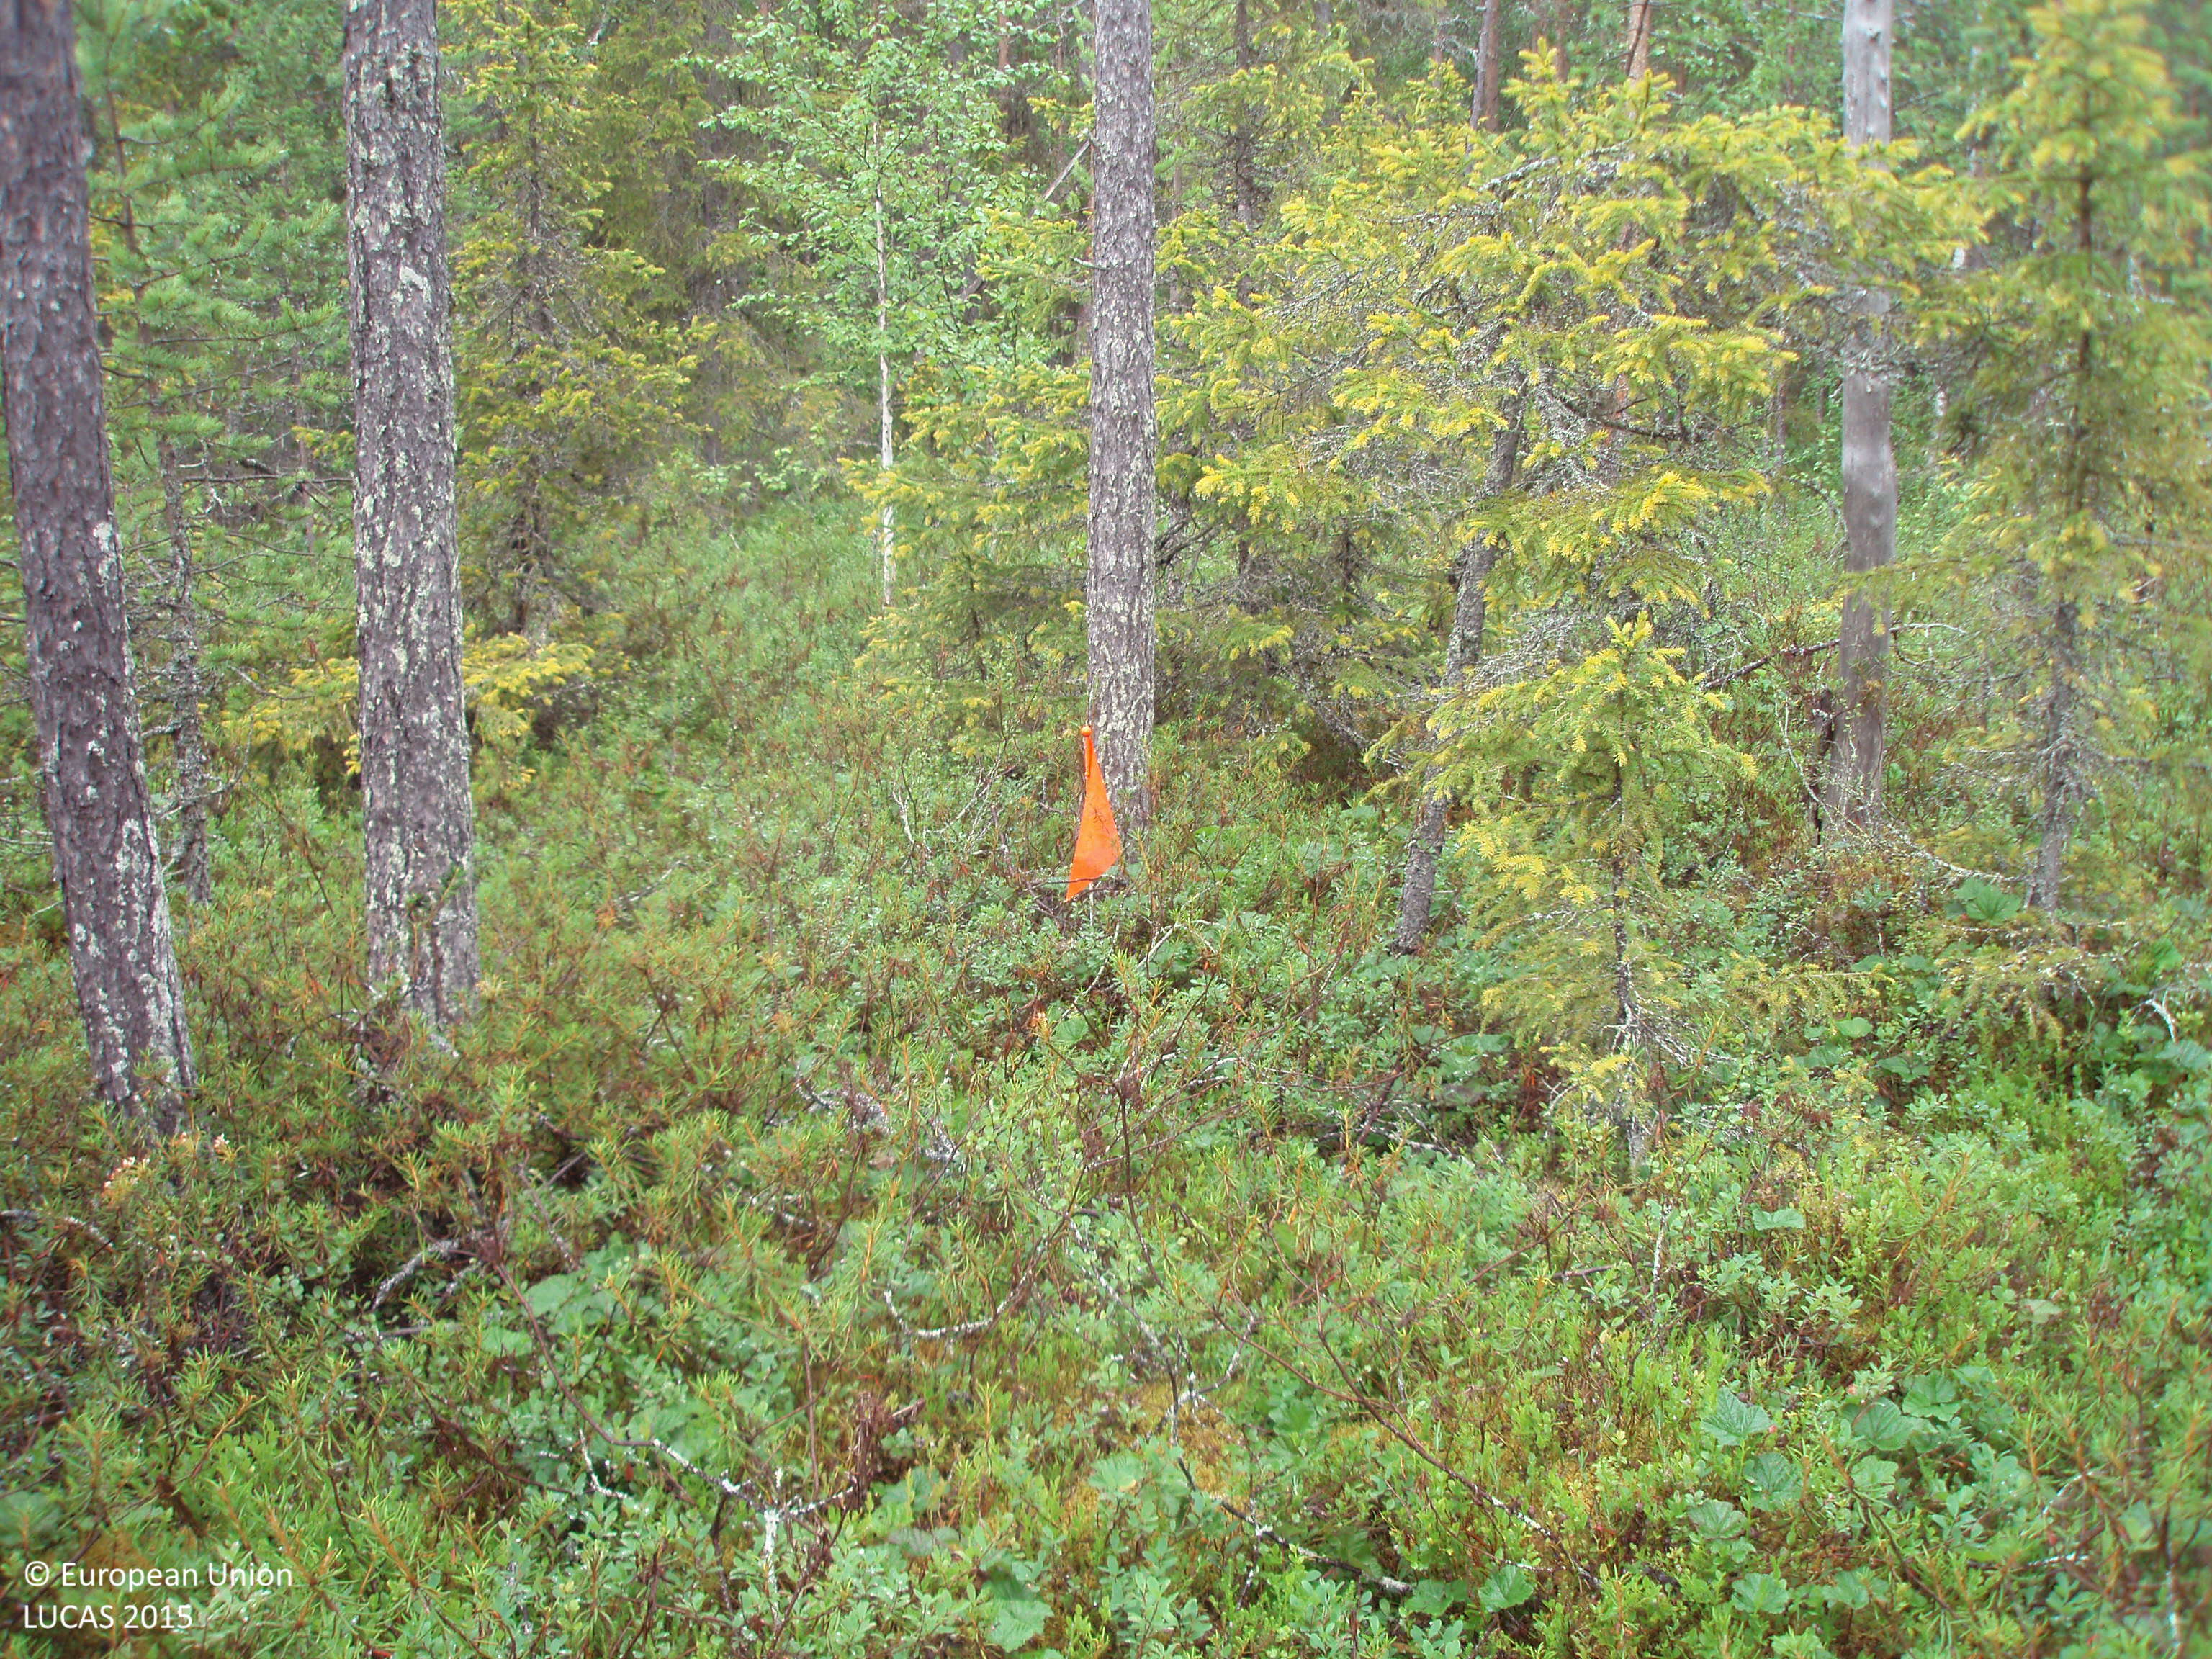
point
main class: Woodland
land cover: Pine dominated mixed woodland
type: boreal forest
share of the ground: > 75 %
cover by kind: coniferous forest trees 50 %, broadleaved forest trees 25 %, shrubs 25 %
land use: Forestry
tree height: > 5 m
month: July
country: FI
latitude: 66.6845
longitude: 27.9436
